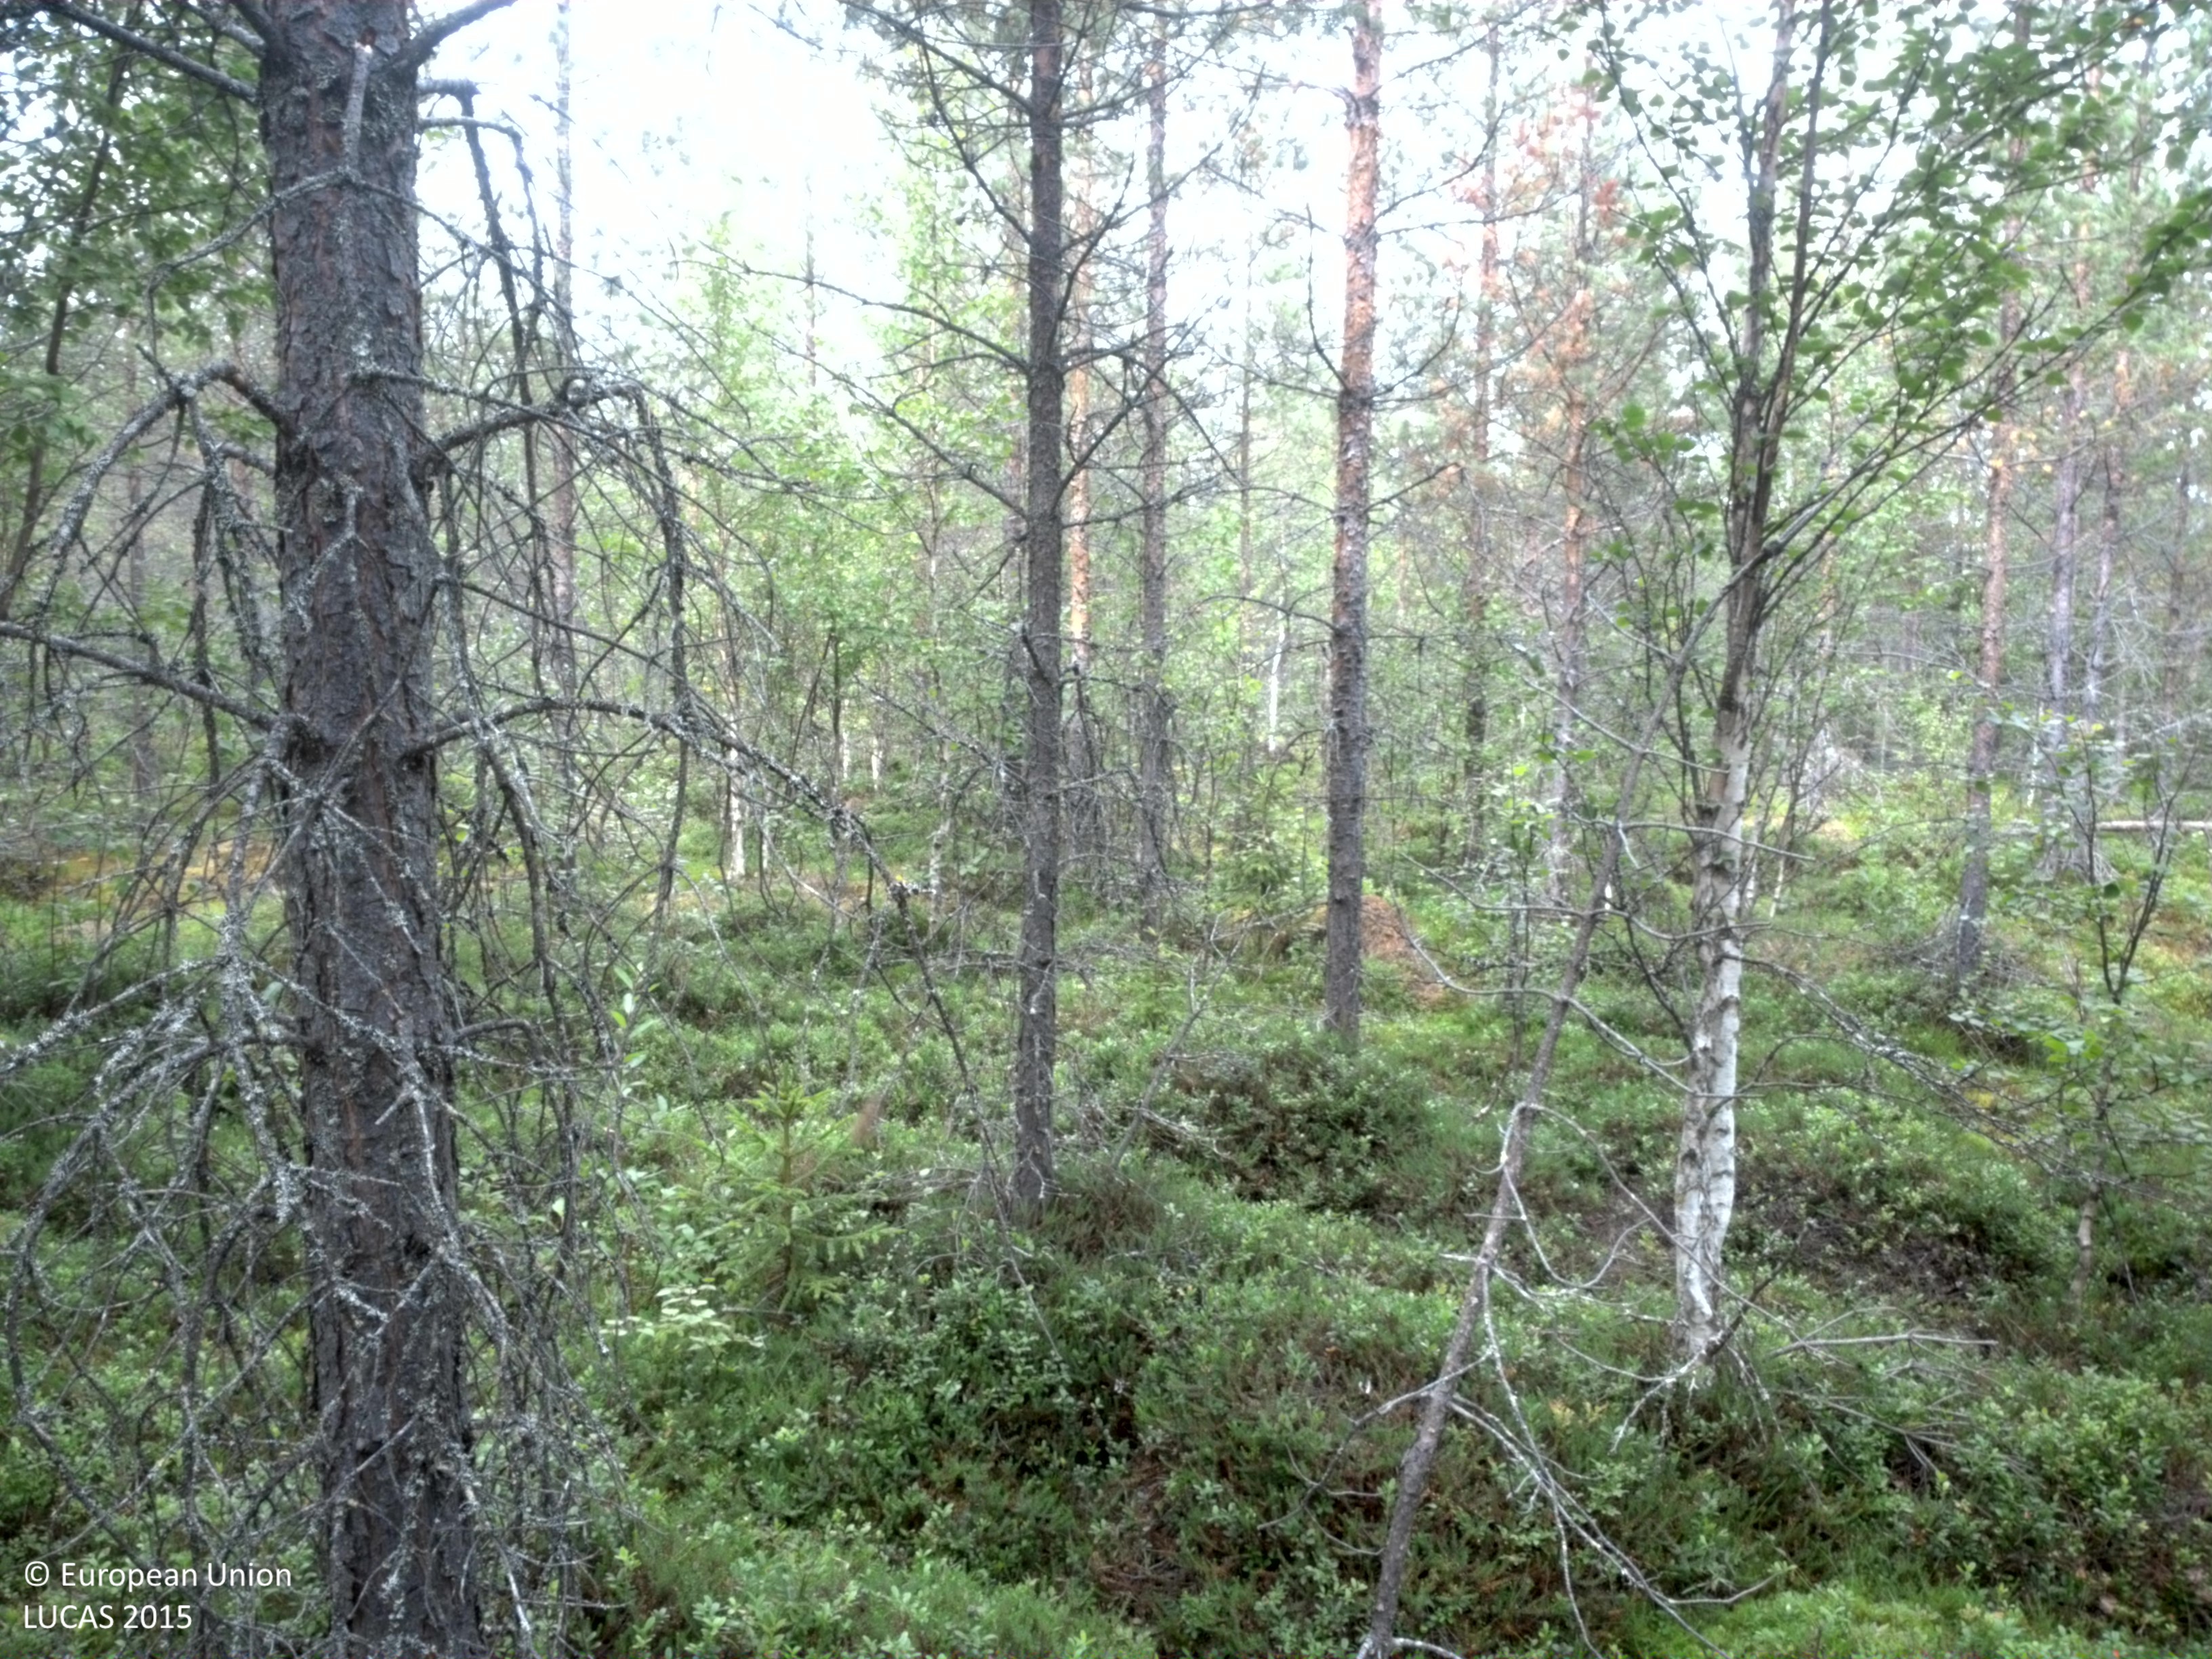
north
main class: Woodland
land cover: Pine dominated mixed woodland
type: boreal forest
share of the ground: 50 - 75 %
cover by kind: coniferous forest trees 45 %, shrubs 30 %, broadleaved forest trees 15 %, lichens and mosses 10 %
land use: Forestry
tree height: > 5 m
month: August
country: SE
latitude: 64.5371
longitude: 20.2946
